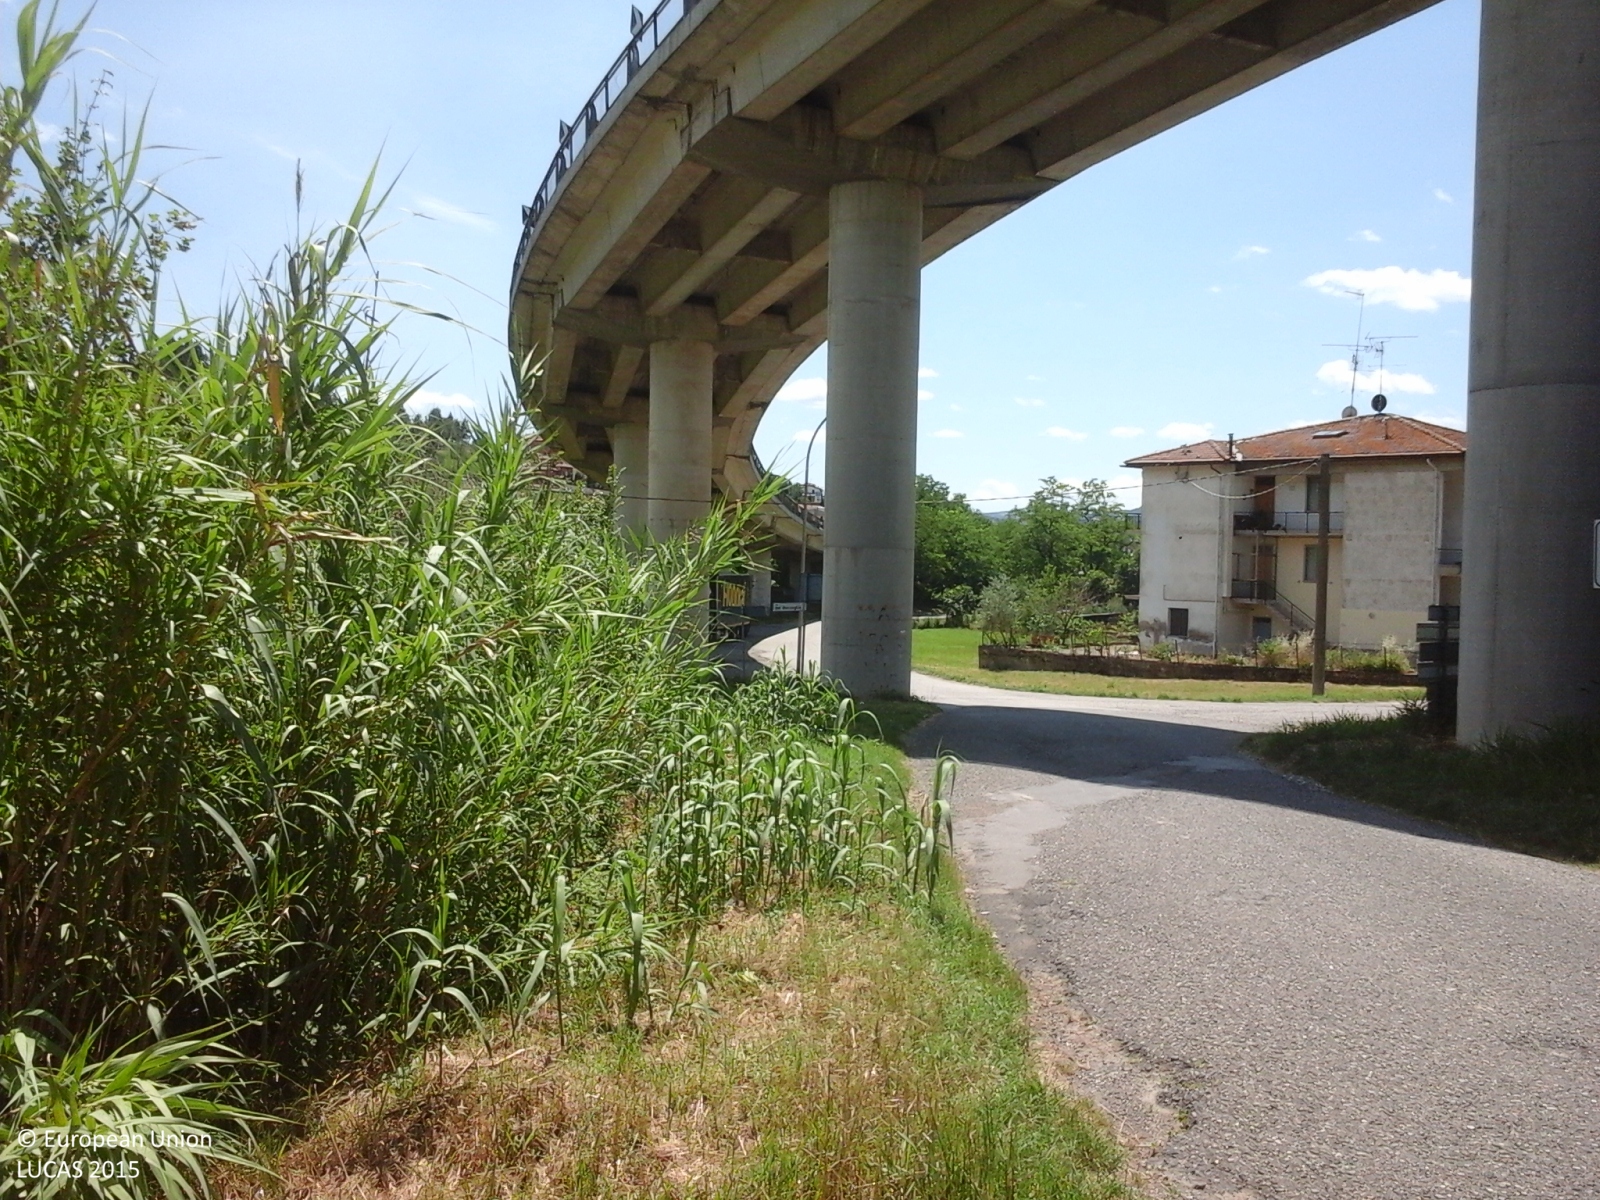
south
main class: Cropland
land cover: Maize
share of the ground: > 75 %
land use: Agriculture (excluding fallow land and kitchen gardens)
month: June
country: IT
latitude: 43.6062
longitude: 10.9761
